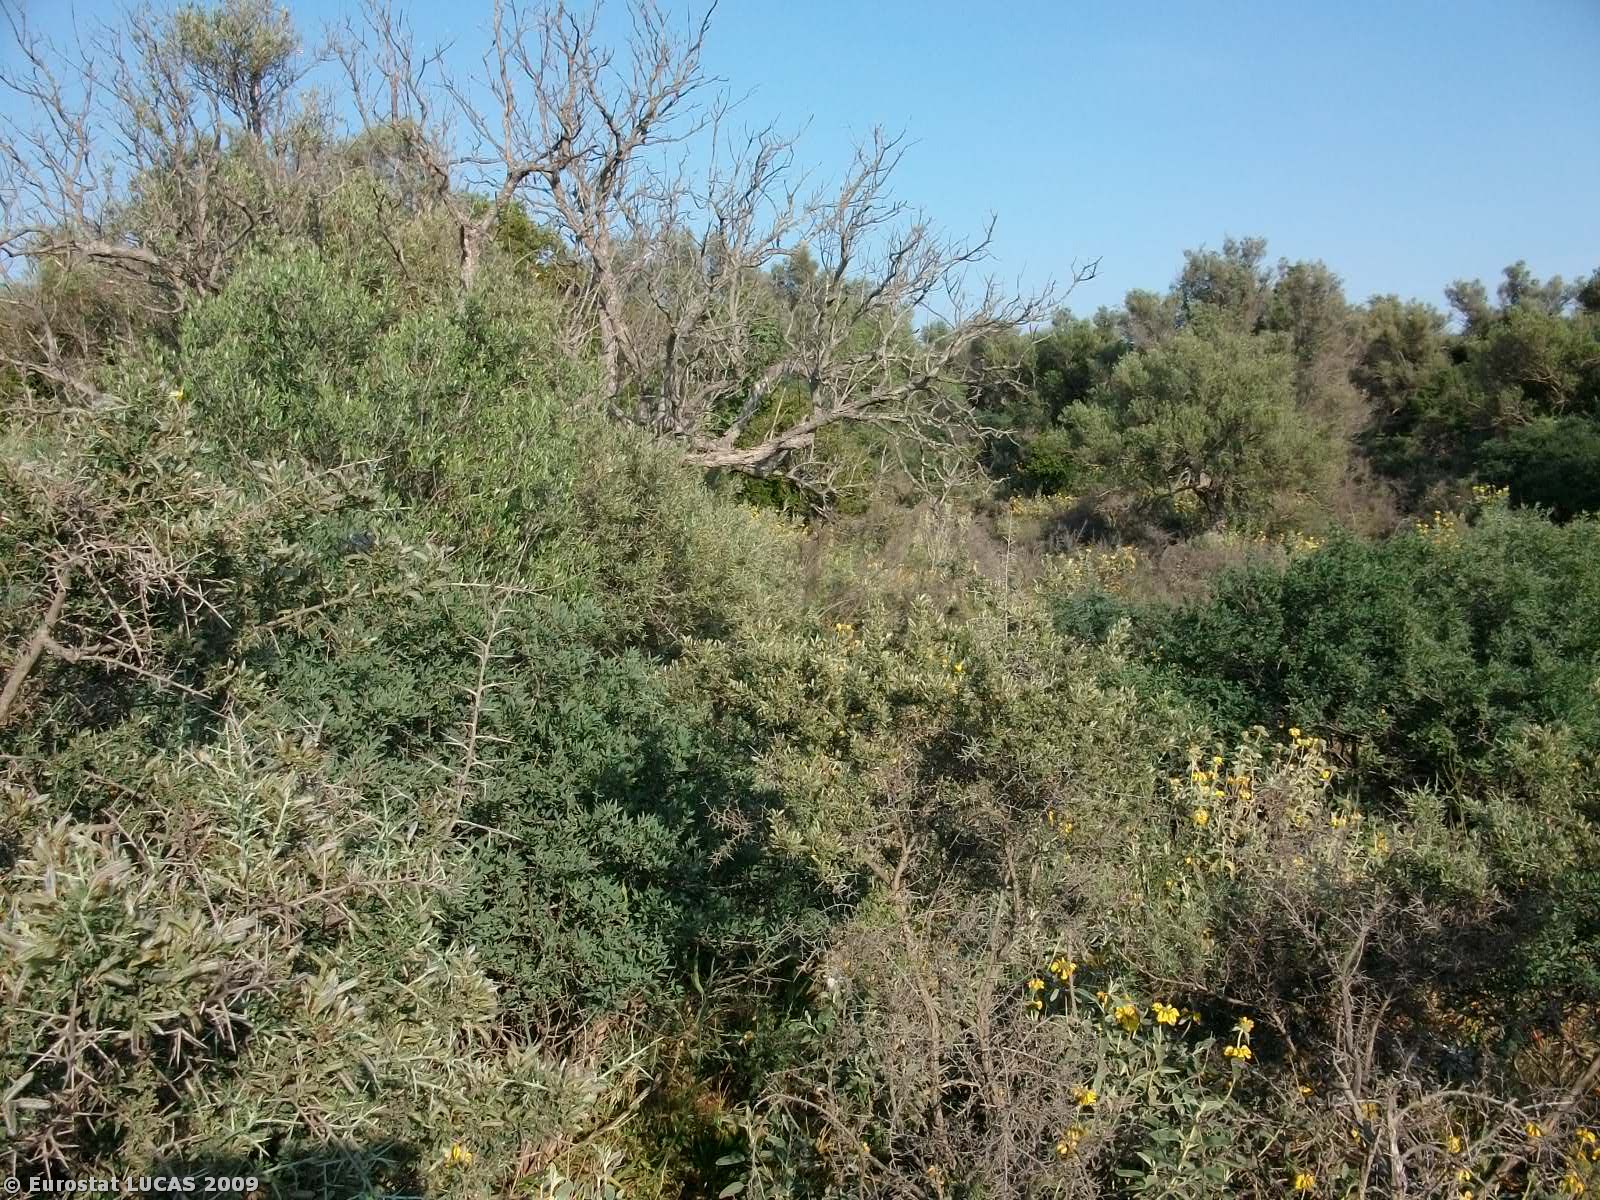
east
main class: Shrubland
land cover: Shrubland with sparse tree cover
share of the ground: > 75 %
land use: Agriculture (excluding fallow land and kitchen gardens)
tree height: > 5 m
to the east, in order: Shrubland with sparse tree cover; Fences; Dry stone walls; Shrubland with sparse tree cover; Shrubland without tree cover; Managed hedges; Dry stone walls; Fences; Shrubland with sparse tree cover; Olive groves; Coniferous woodland; Olive groves; Mixed woodland; Bare land; Olive groves; Shrubland with sparse tree cover; Dry stone walls; Olive groves
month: May
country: GR
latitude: 35.4209
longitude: 24.2265
